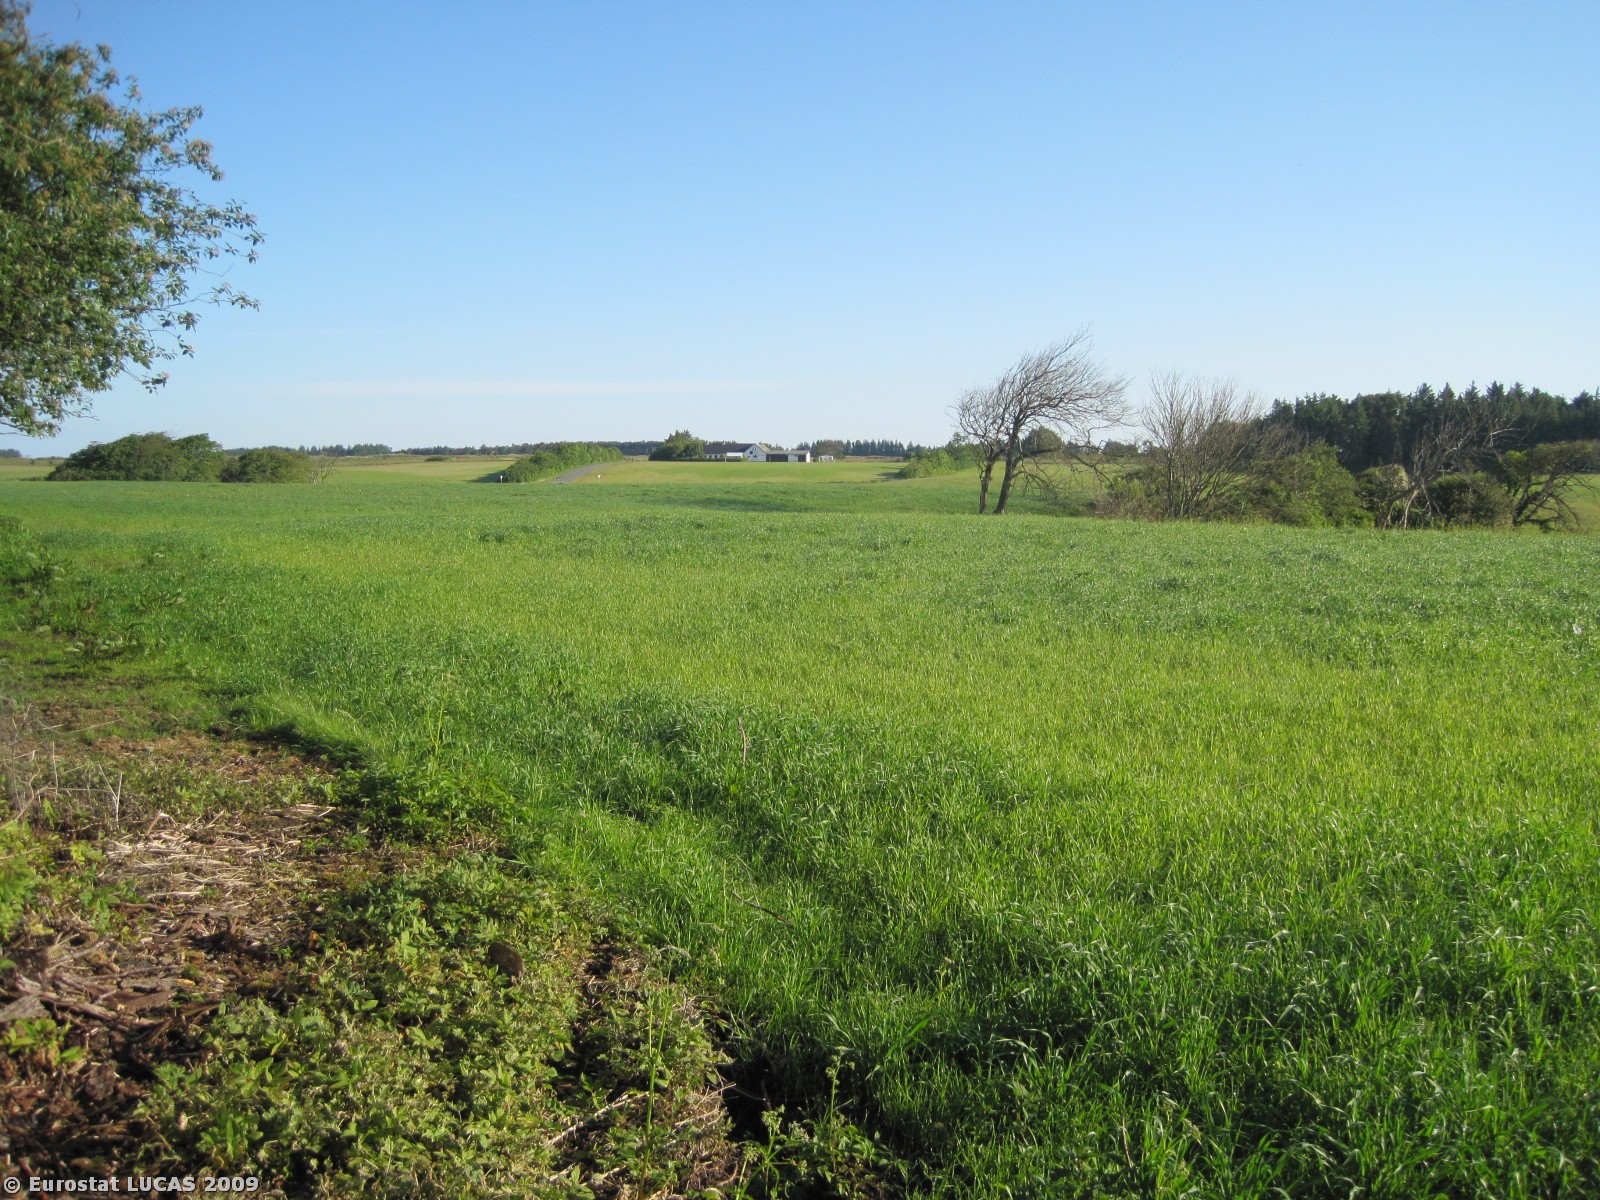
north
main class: Woodland
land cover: Broadleaved woodland
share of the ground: > 75 %
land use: Residential
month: June
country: DK
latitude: 57.4821
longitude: 9.8834
